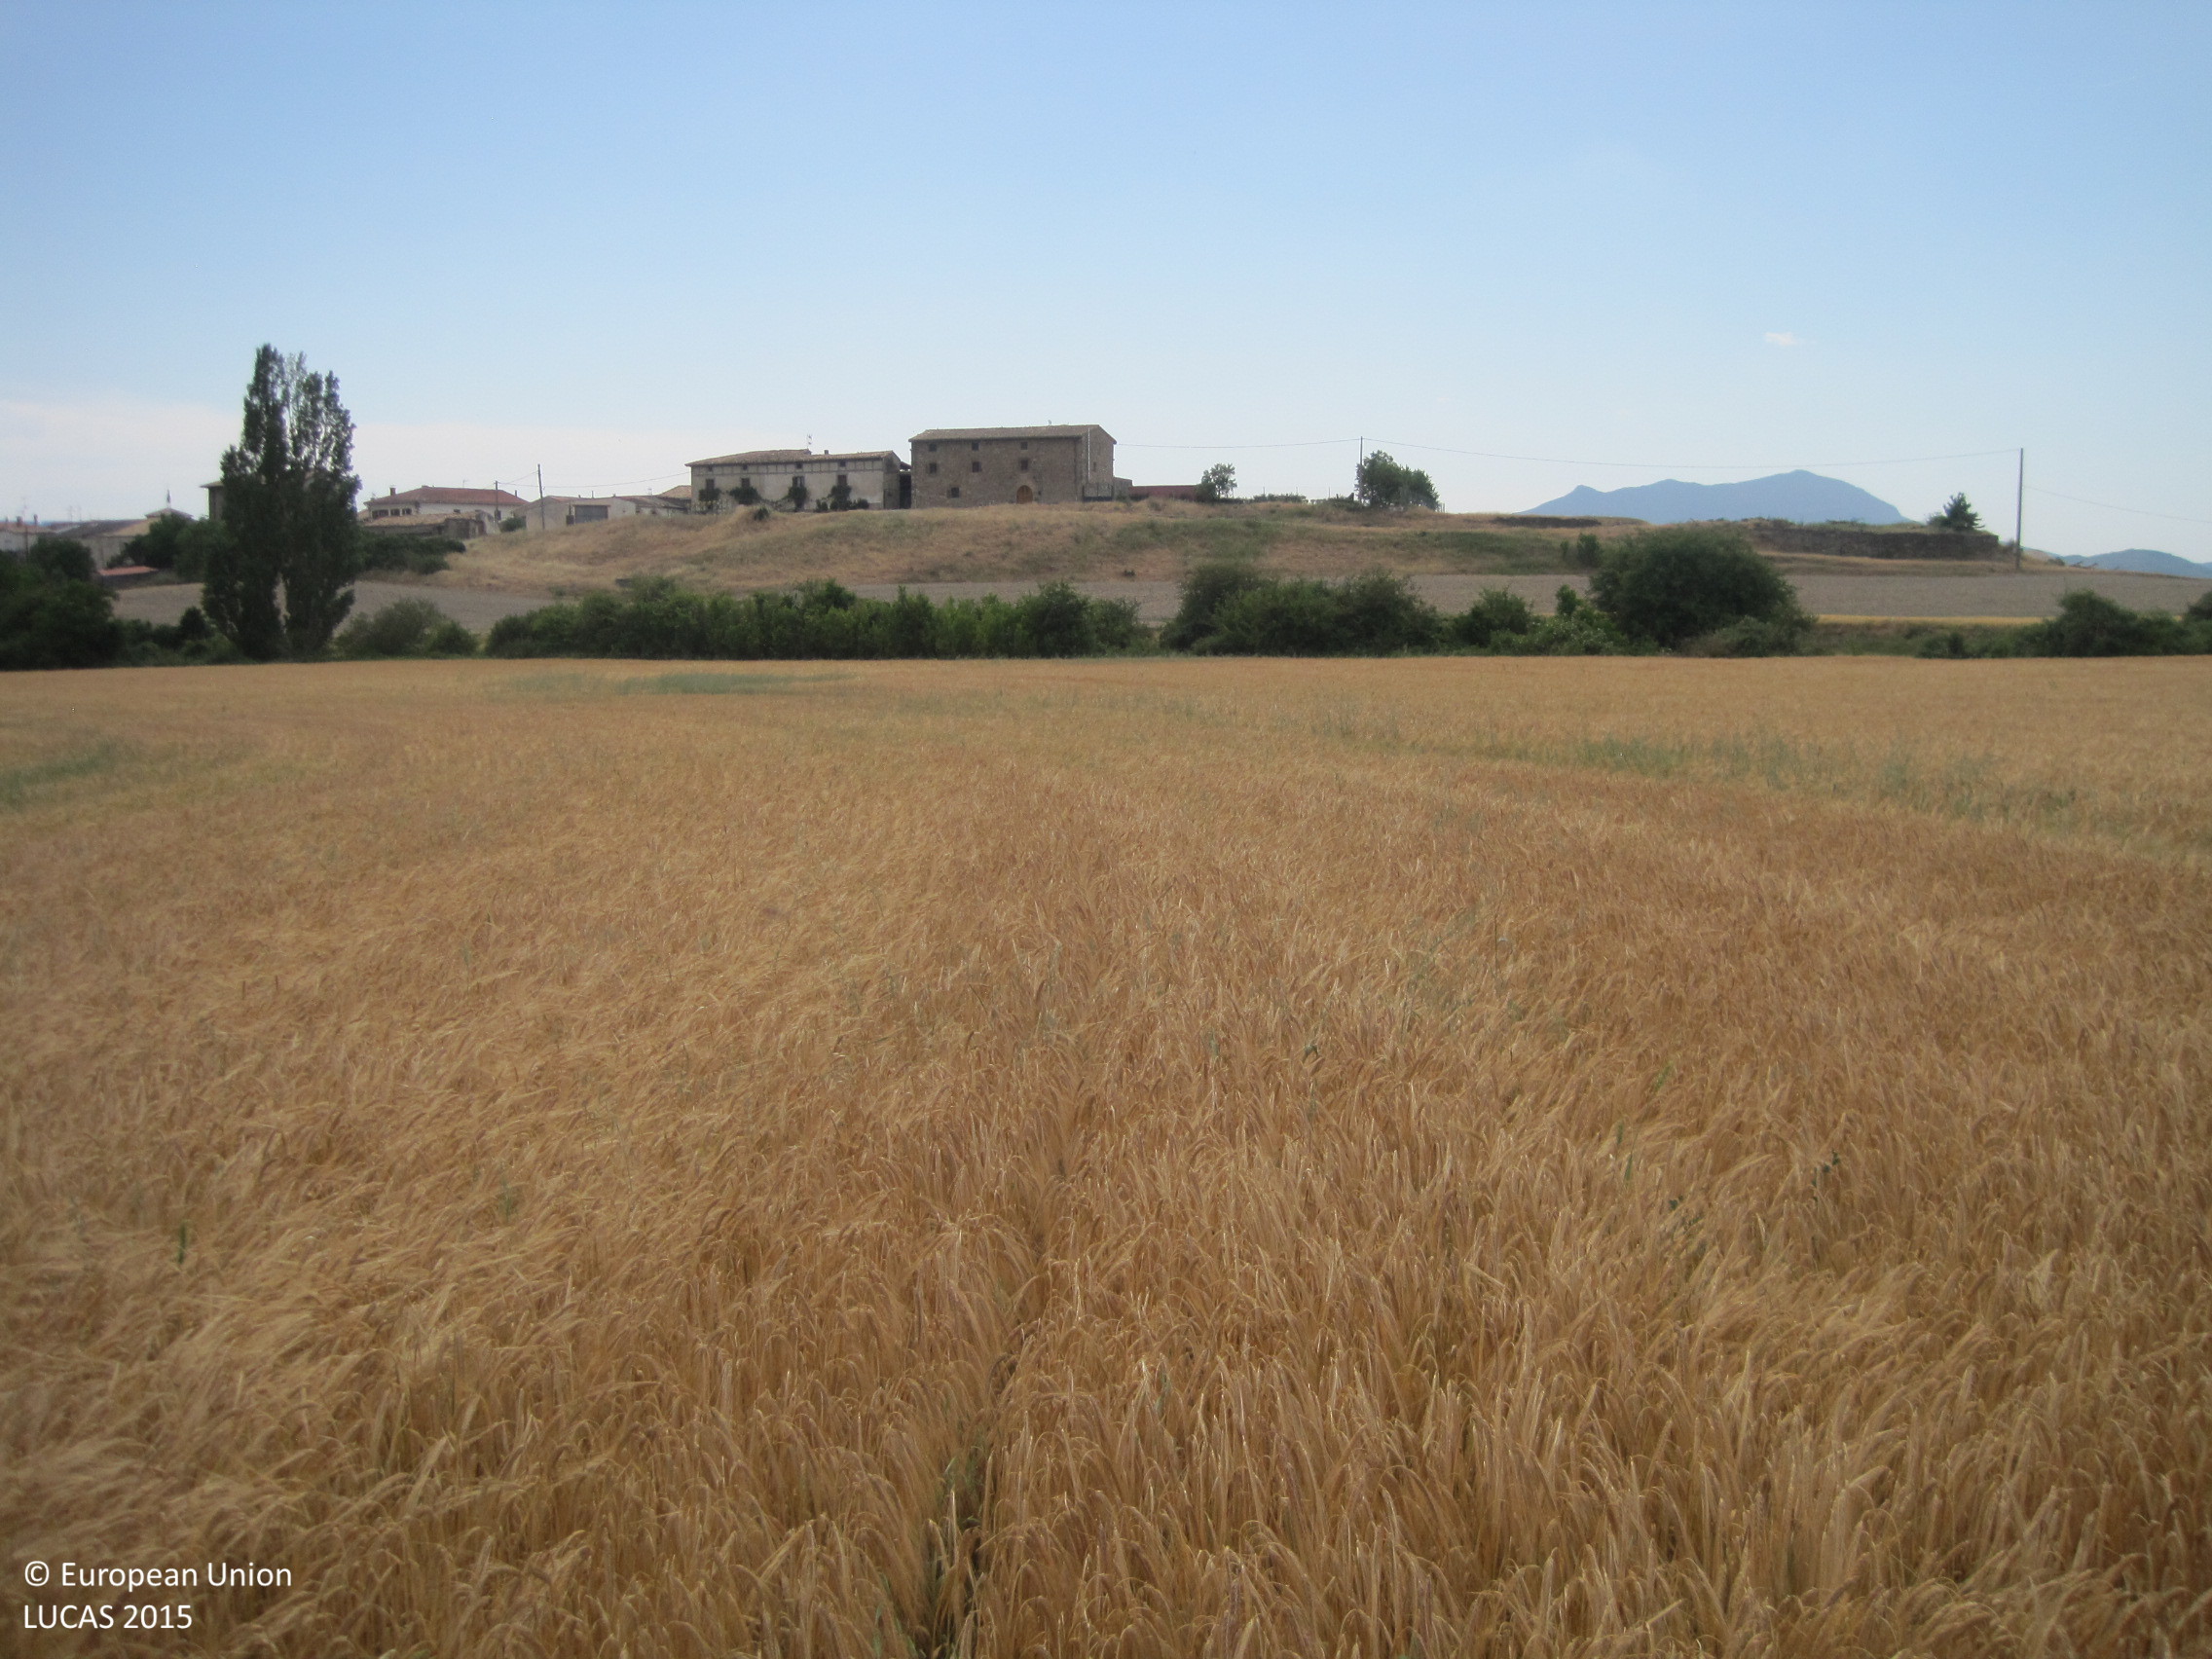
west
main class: Cropland
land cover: Barley
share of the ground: > 75 %
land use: Agriculture (excluding fallow land and kitchen gardens)
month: June
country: ES
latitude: 42.6810
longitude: -1.2493
